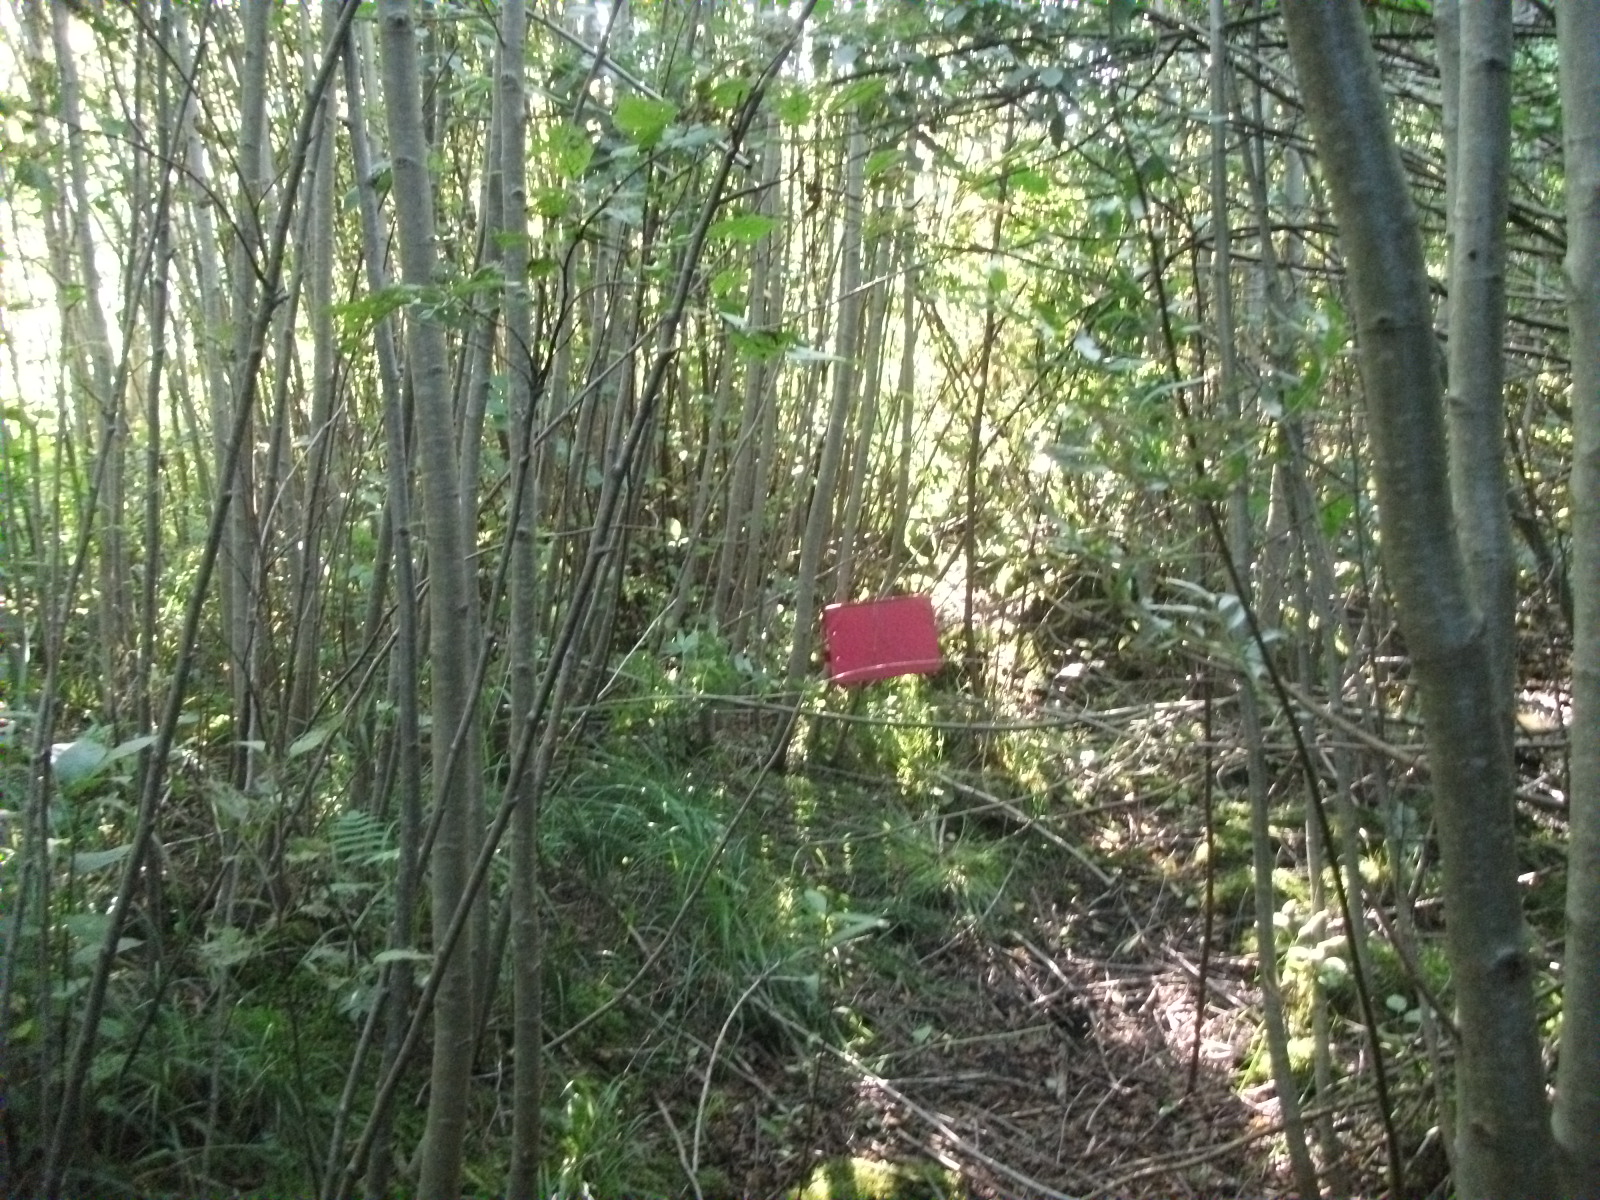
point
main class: Woodland
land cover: Broadleaved woodland
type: non-riverine alder, birch or aspen forest
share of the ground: > 75 %
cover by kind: broadleaved forest trees 95 %, shrubs 5 %
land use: Forestry
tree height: > 5 m
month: August
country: LV
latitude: 56.8900
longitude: 26.2408
